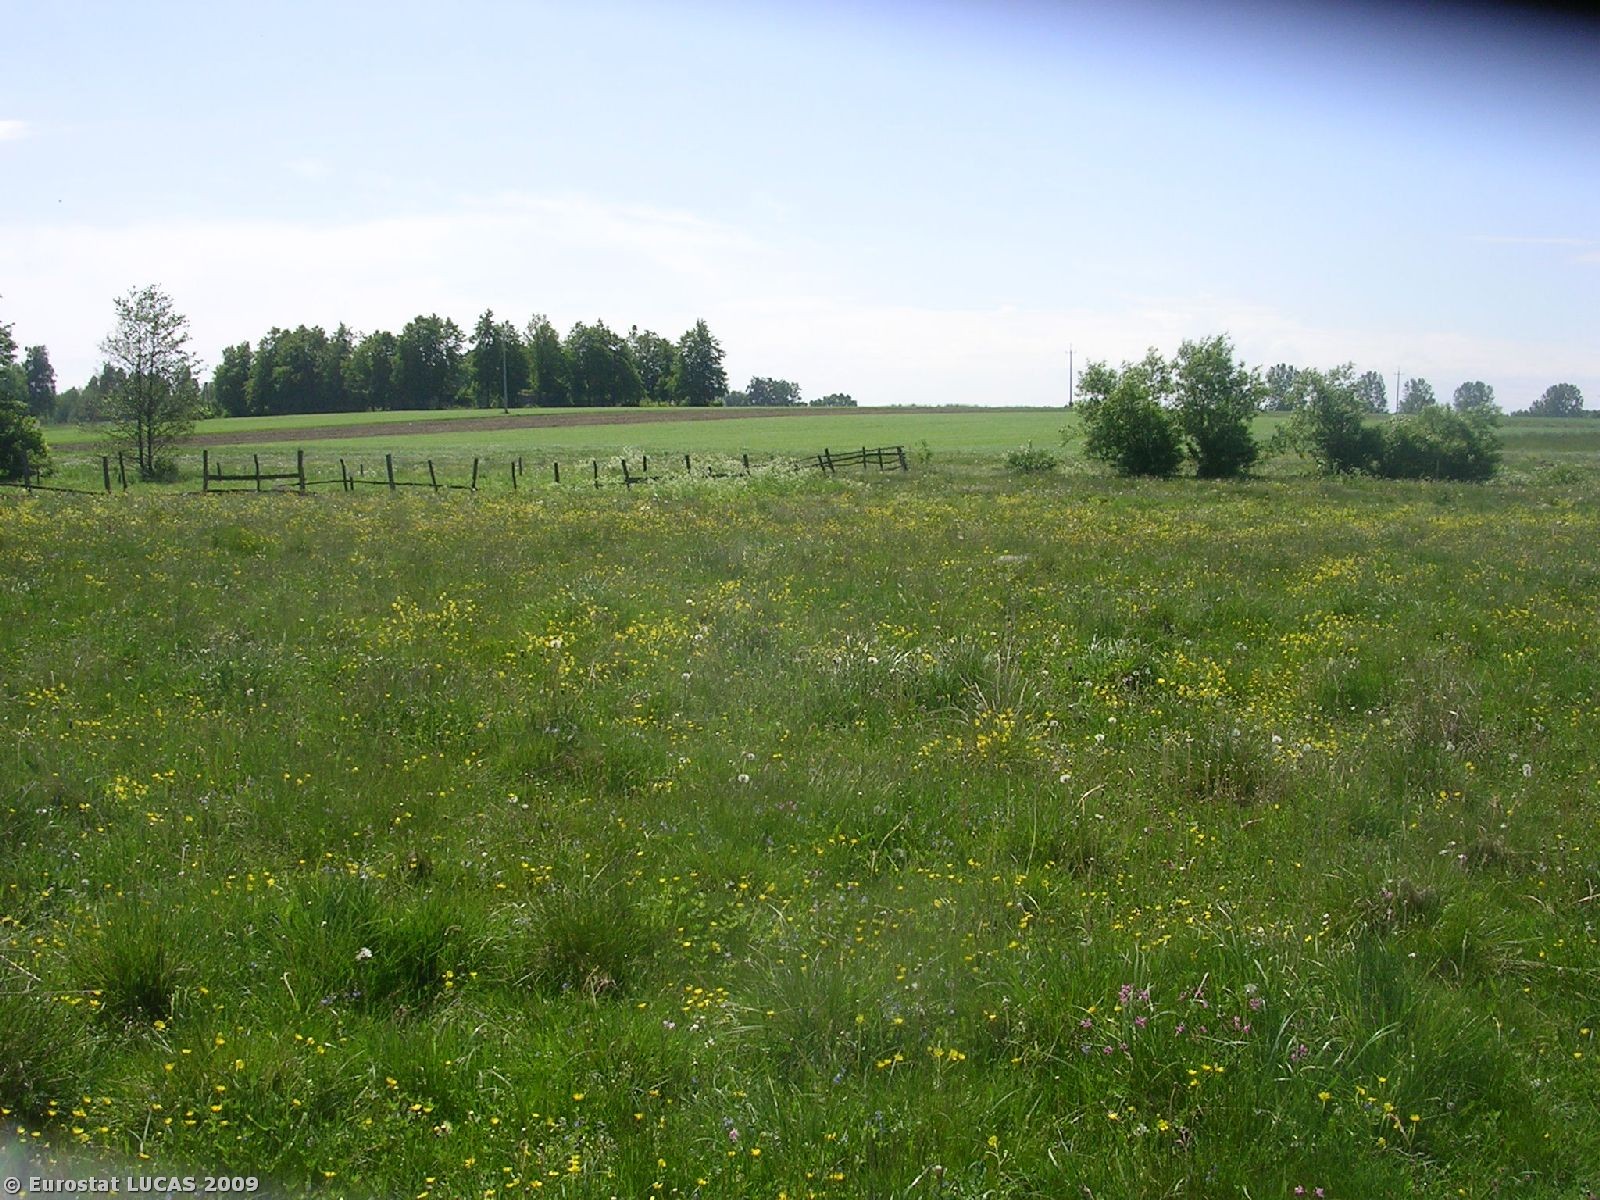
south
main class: Grassland
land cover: Grassland without tree/shrub cover
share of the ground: > 75 %
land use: Agriculture (excluding fallow land and kitchen gardens)
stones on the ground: < 10 %
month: May
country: PL
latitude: 53.5137
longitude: 23.3667
